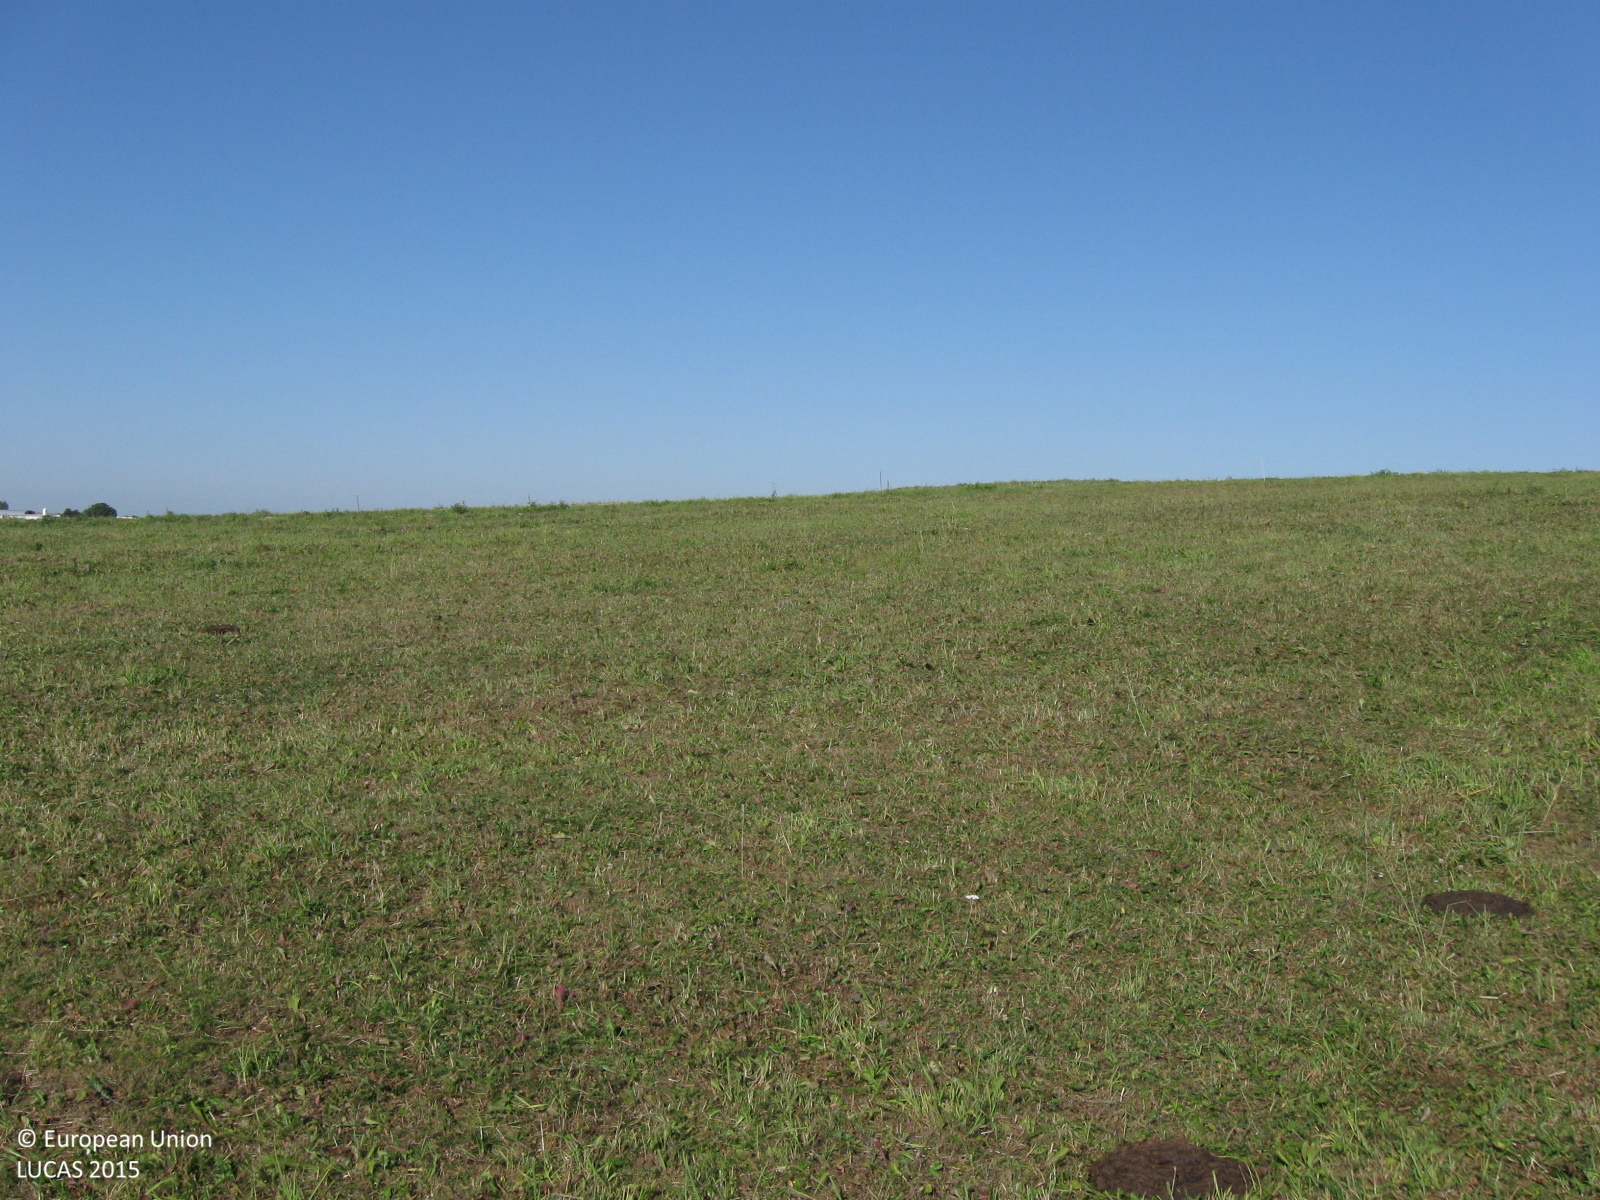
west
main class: Grassland
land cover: Grassland without tree/shrub cover
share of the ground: > 75 %
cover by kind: herbaceous plants 100 %
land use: Agriculture (excluding fallow land and kitchen gardens)
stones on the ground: < 10 %
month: August
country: LT
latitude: 55.4250
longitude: 22.5284
